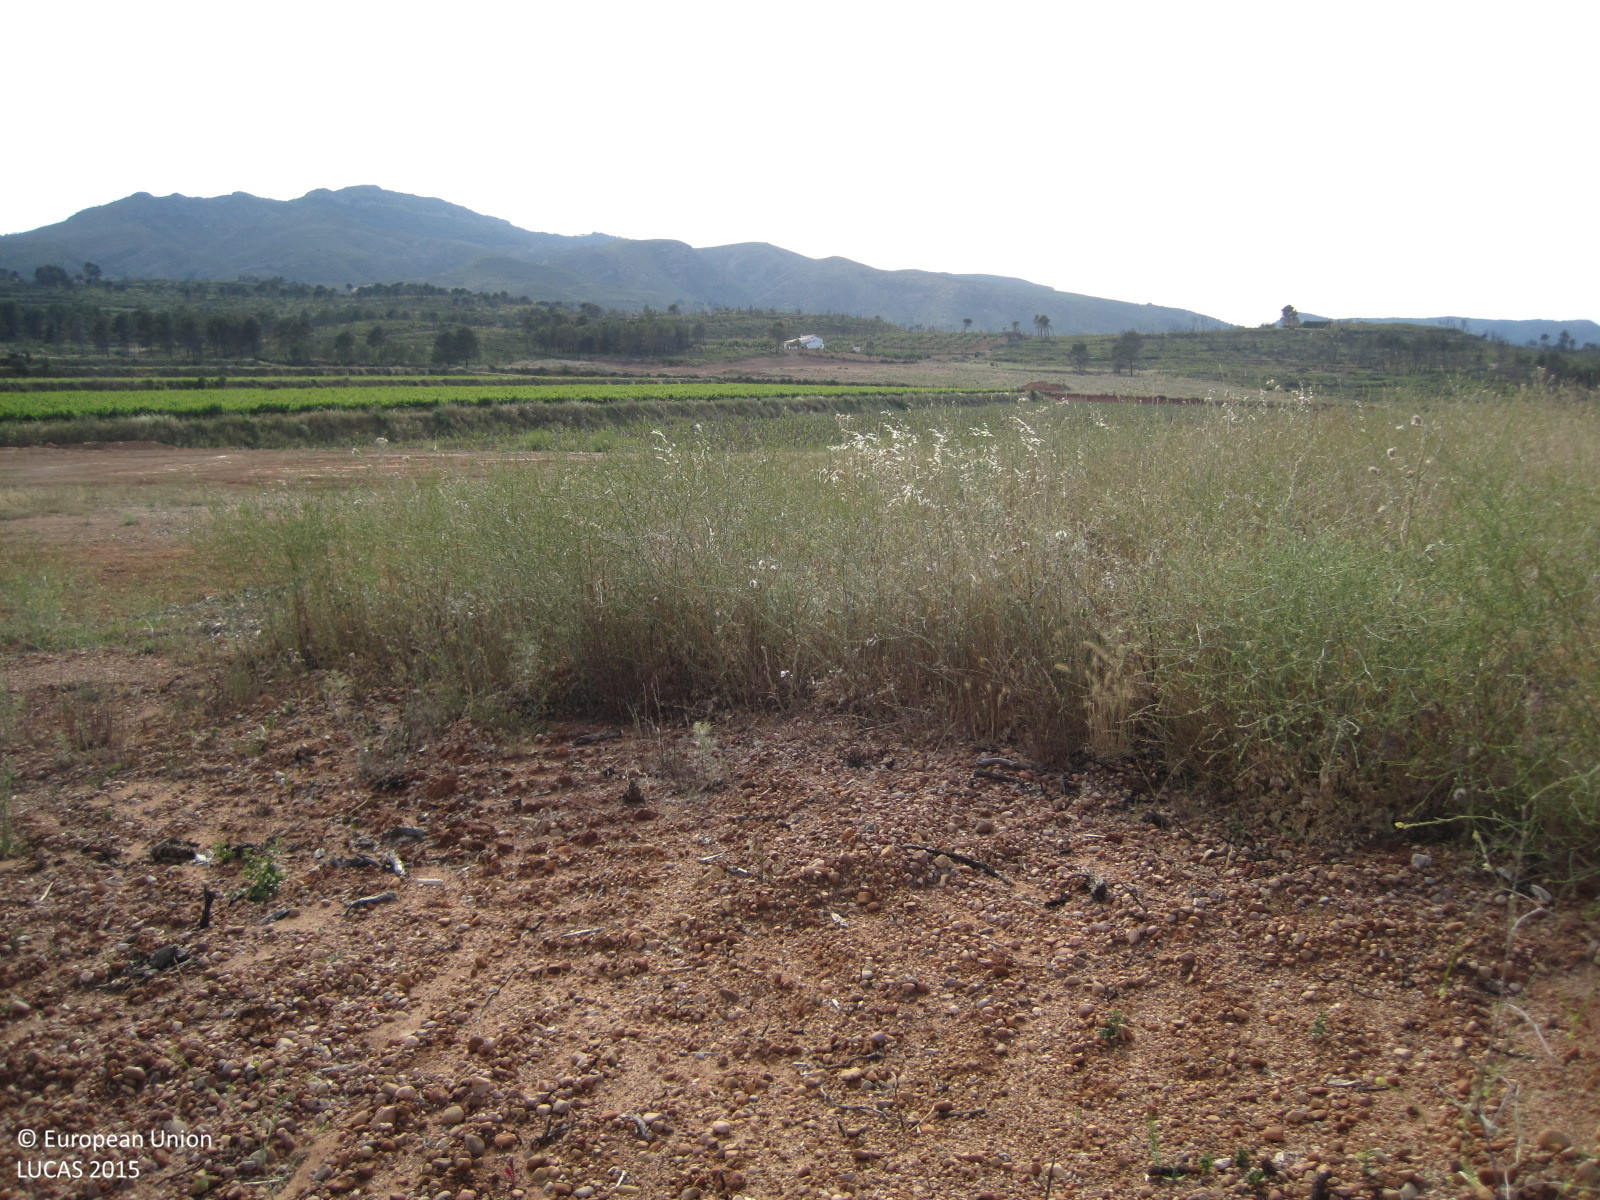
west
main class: Grassland
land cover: Spontaneously vegetated surfaces
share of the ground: 10 - 25 %
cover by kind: unconsolidated bare surface 85 %, herbaceous plants 15 %
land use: Abandoned areas
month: May
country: ES
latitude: 39.3332
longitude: -0.8686
